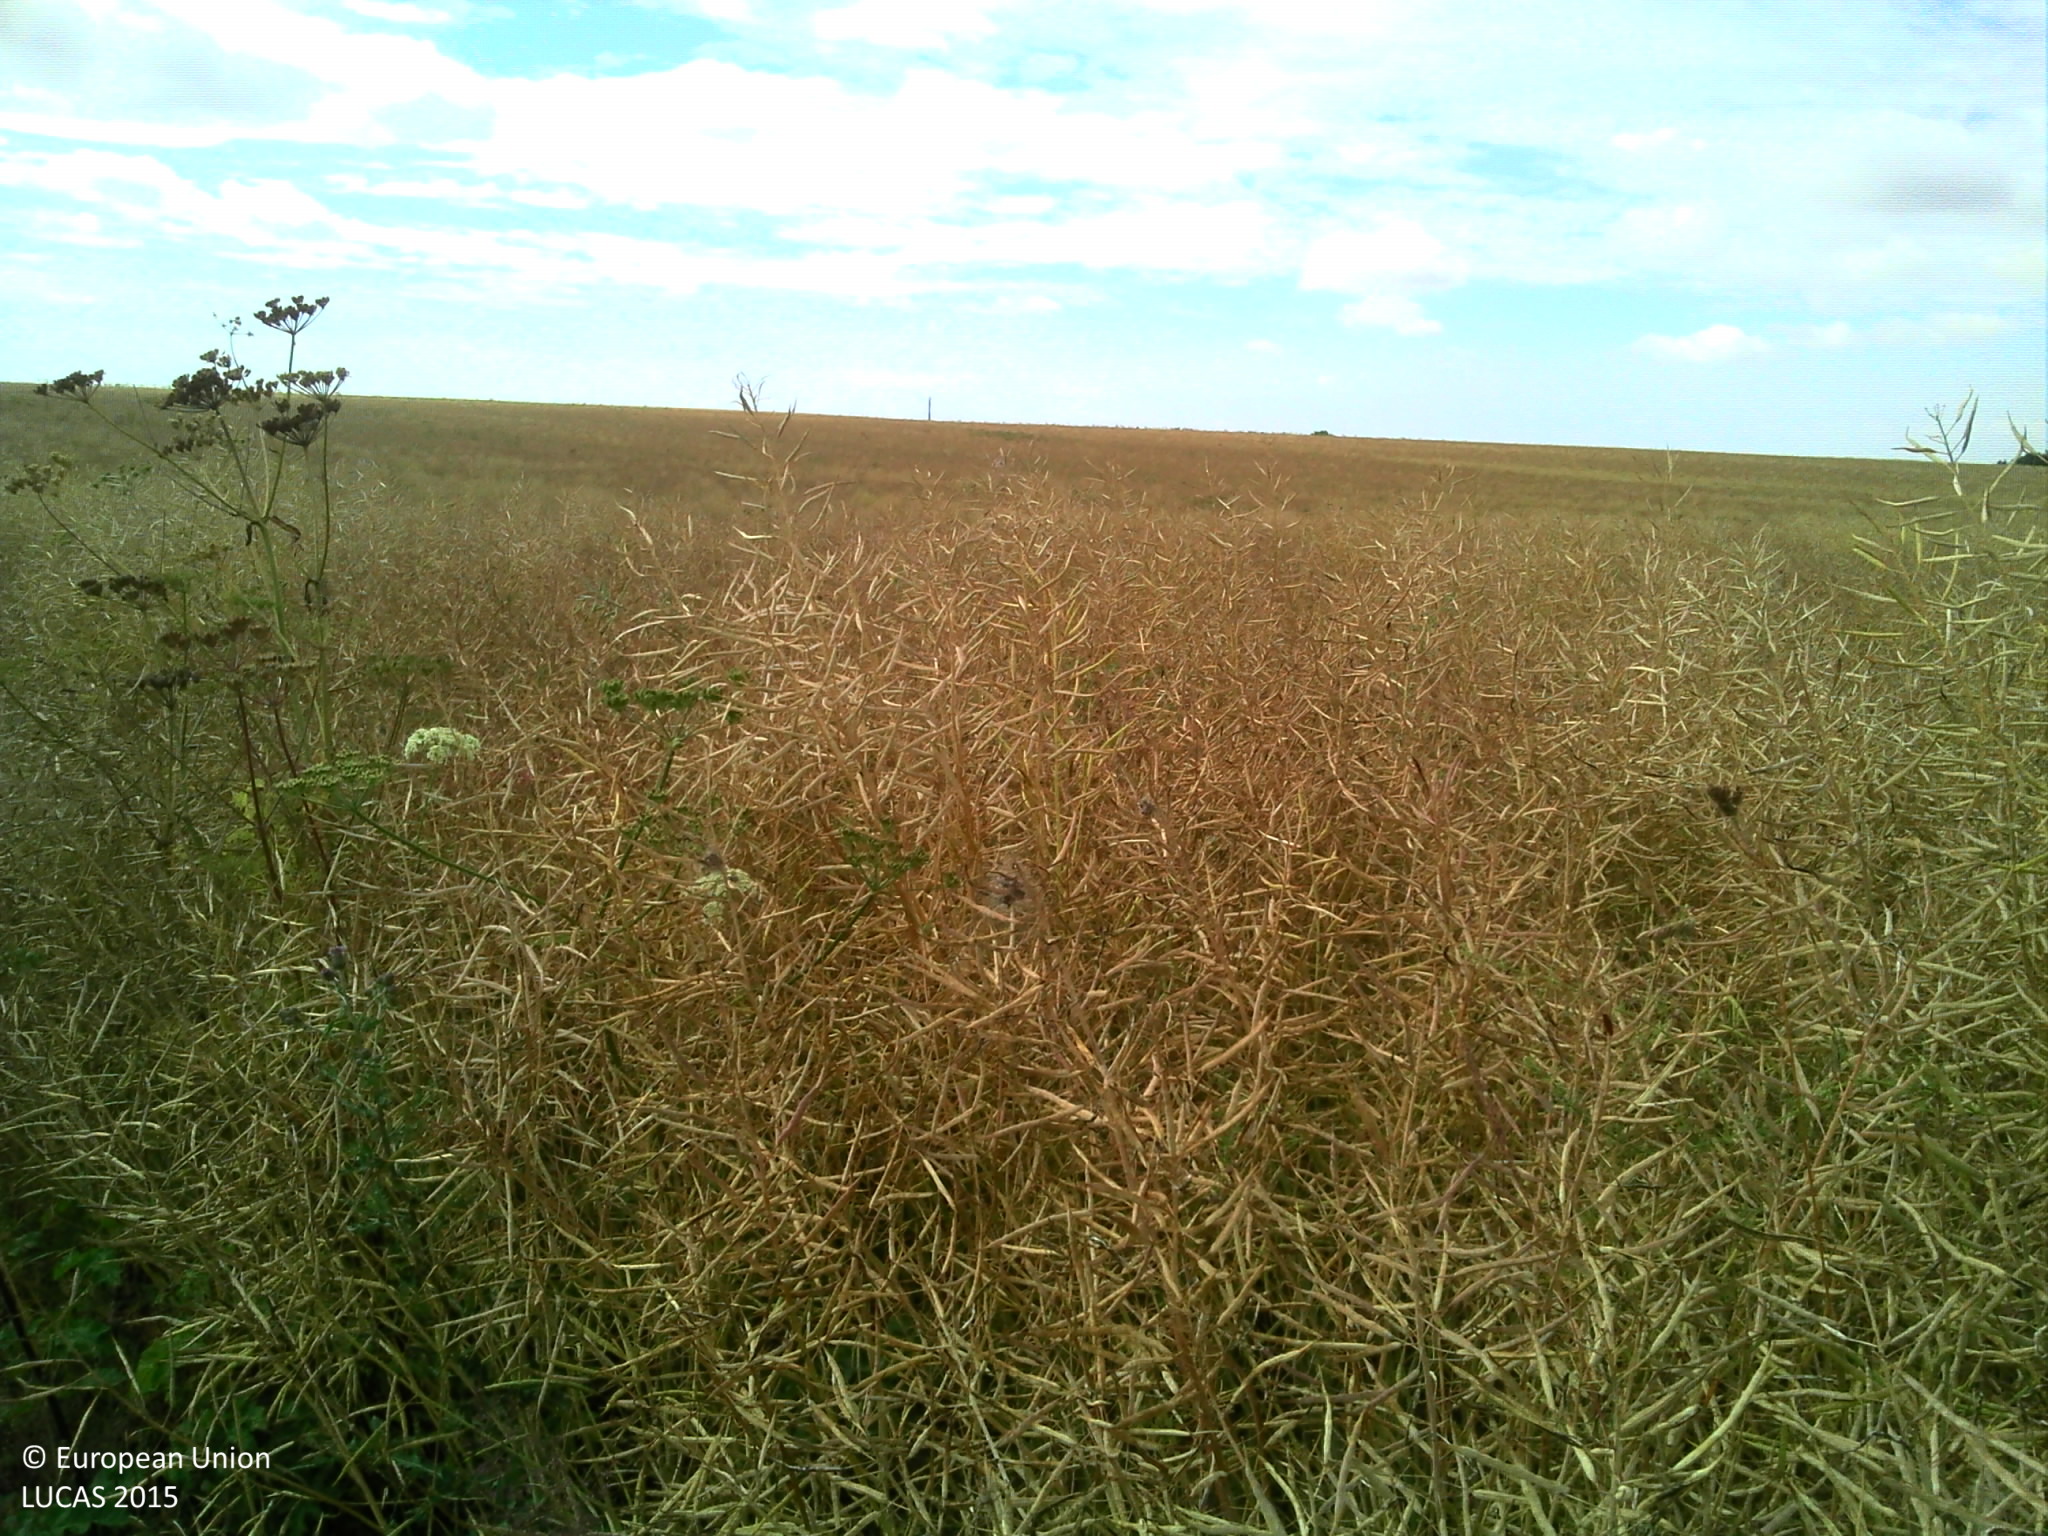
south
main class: Cropland
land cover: Rape and turnip rape
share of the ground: > 75 %
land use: Agriculture (excluding fallow land and kitchen gardens)
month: July
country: FR
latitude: 49.4454
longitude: 5.9304
